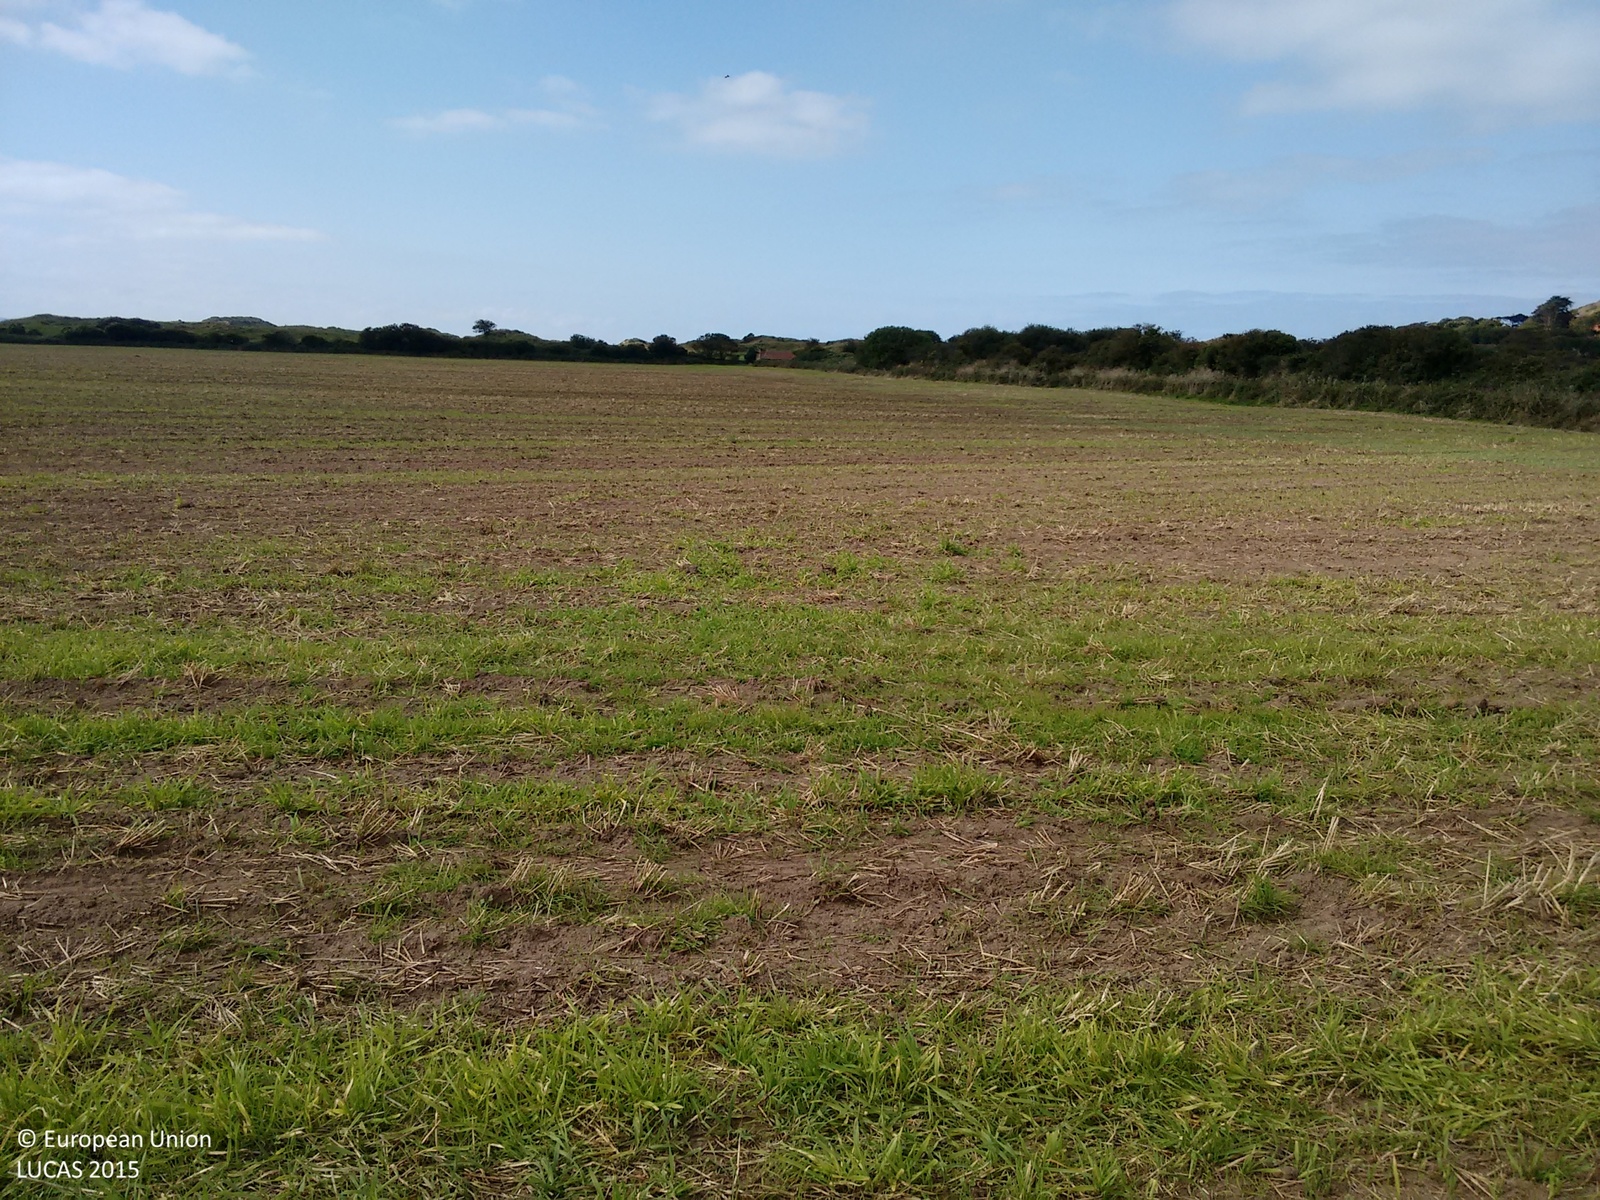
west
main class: Cropland
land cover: Barley
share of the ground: > 75 %
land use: Agriculture (excluding fallow land and kitchen gardens)
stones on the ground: < 10 %
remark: Harvested field
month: September
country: GB
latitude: 51.1163
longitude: -4.1983
